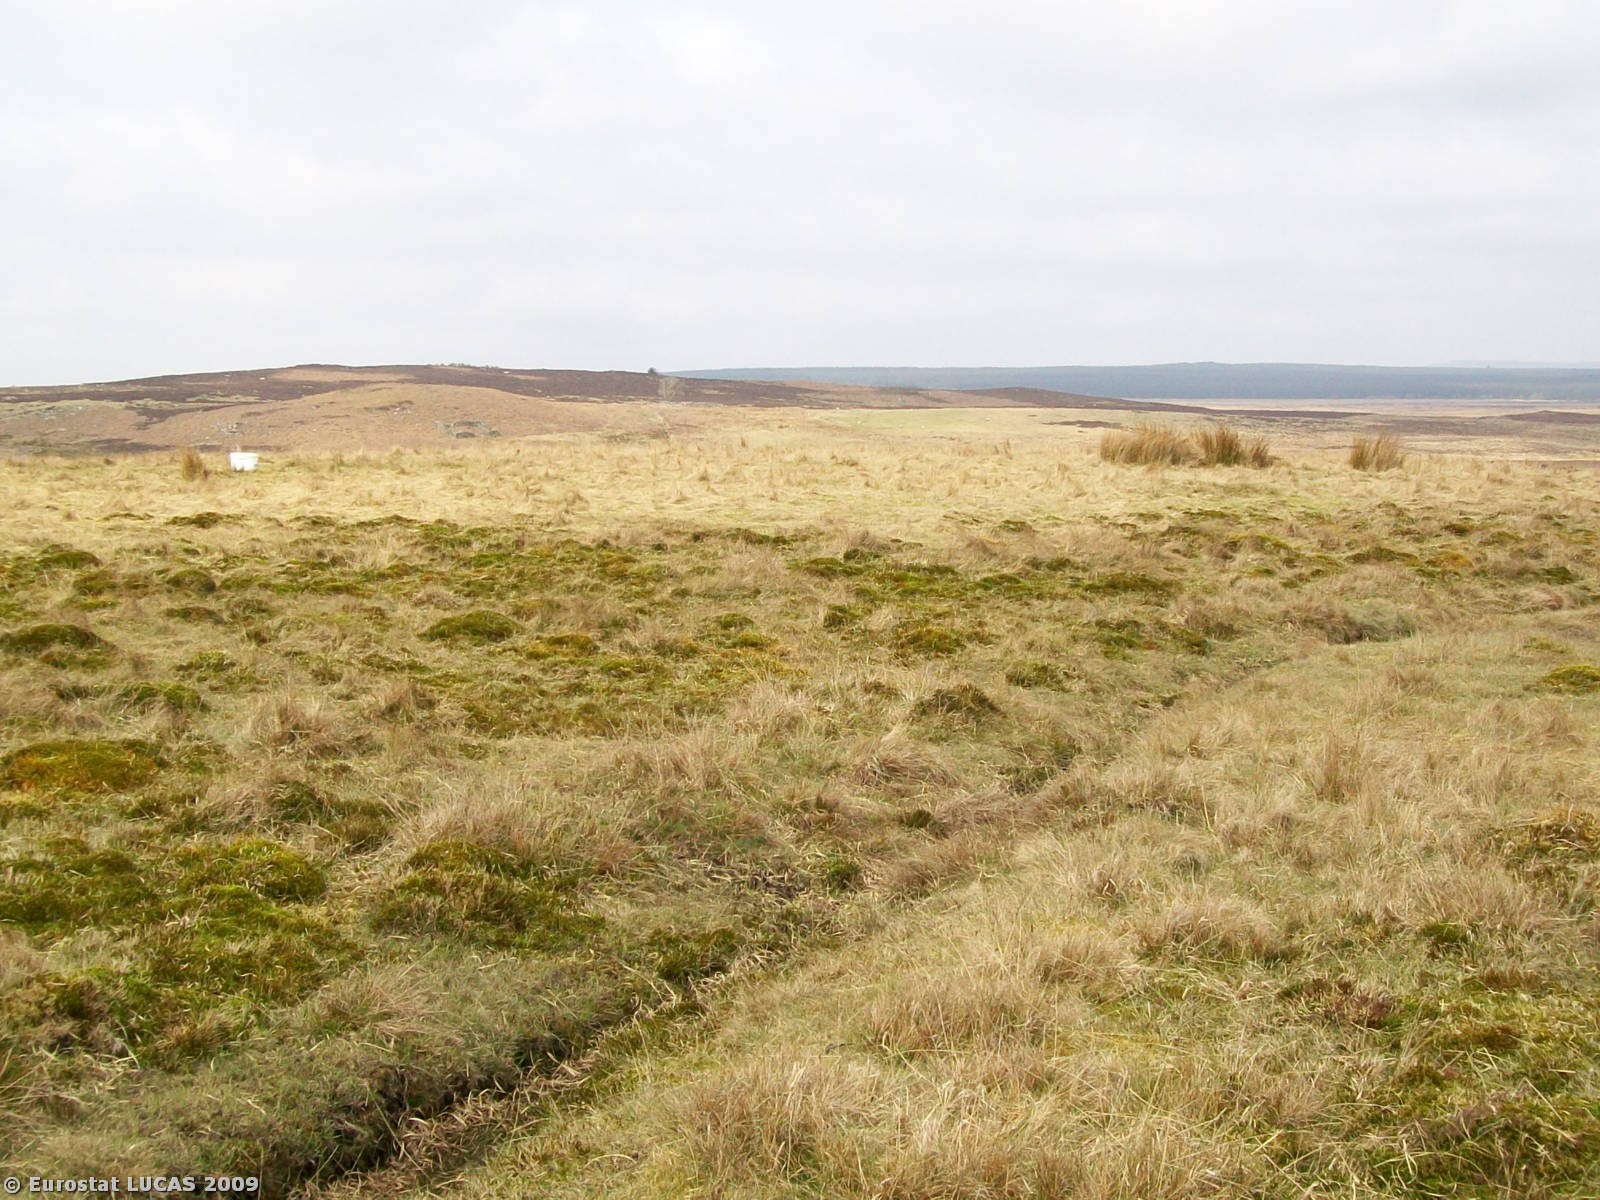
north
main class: Grassland
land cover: Grassland without tree/shrub cover
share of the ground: > 75 %
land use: Agriculture (excluding fallow land and kitchen gardens)
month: April
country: GB
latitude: 55.1819
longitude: -2.0369
